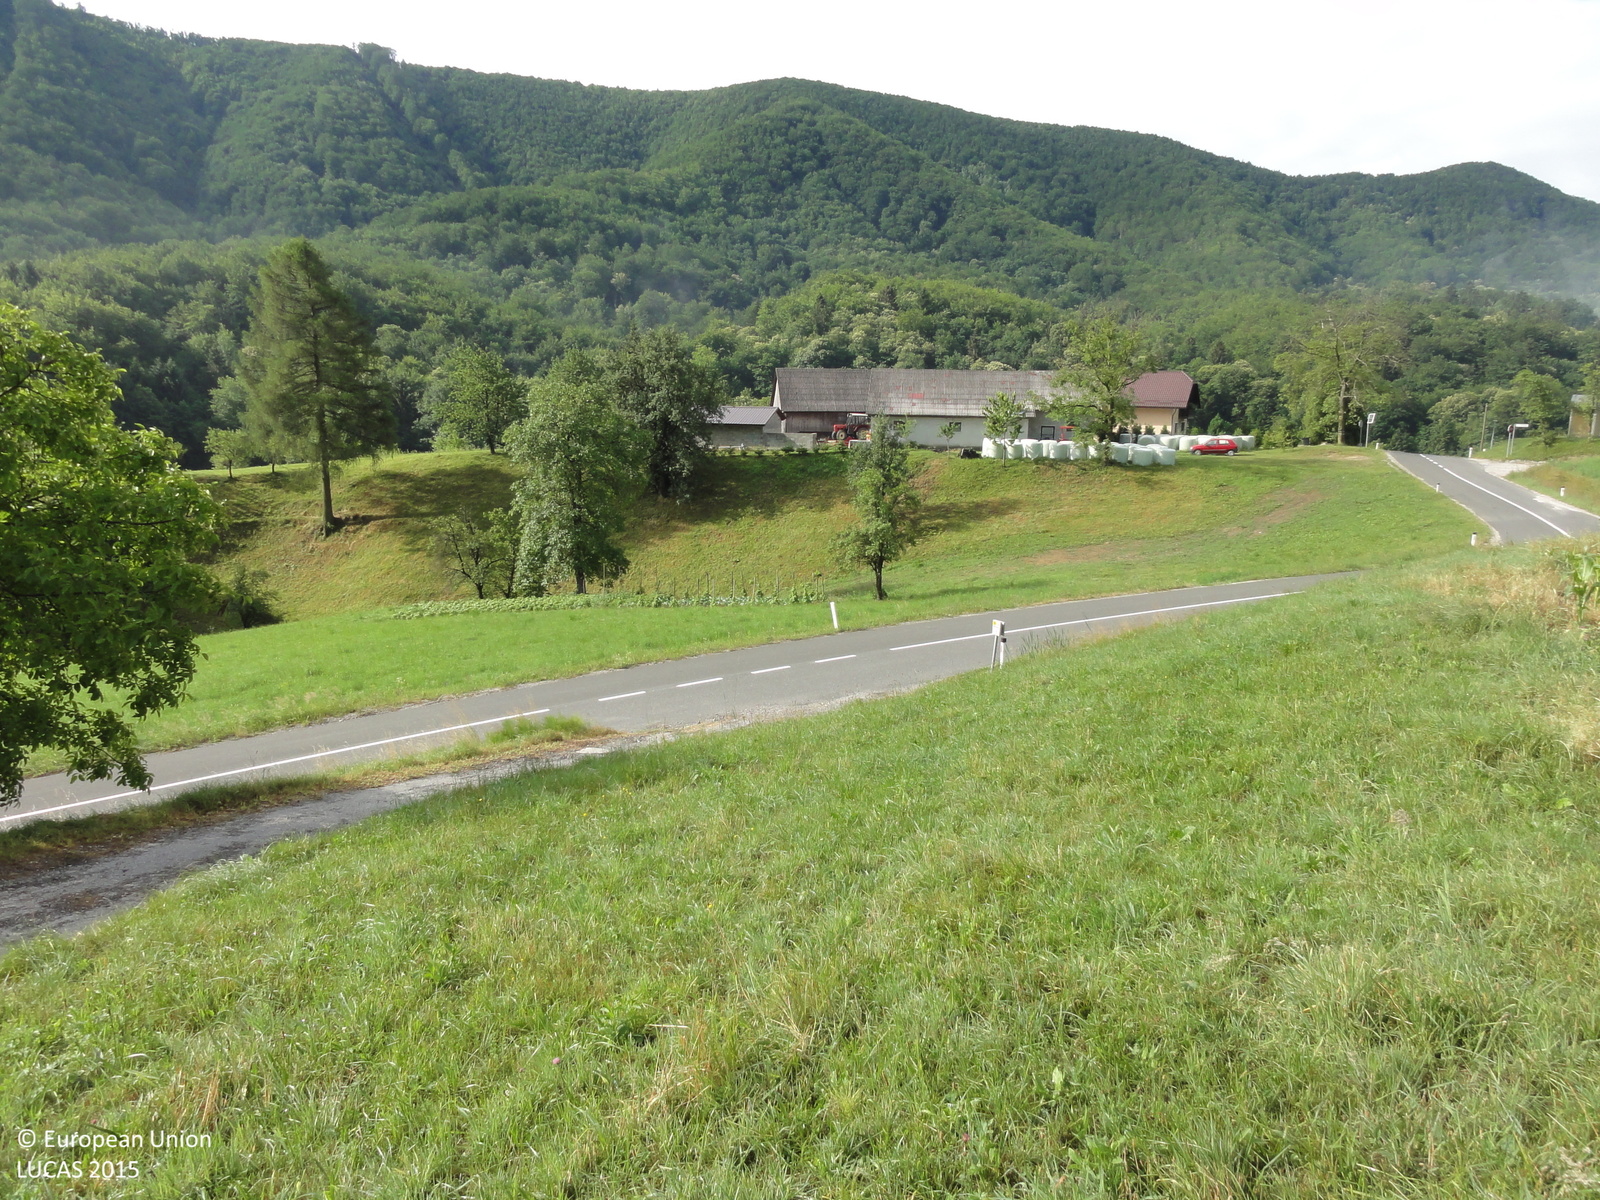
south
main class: Grassland
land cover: Grassland without tree/shrub cover
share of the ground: > 75 %
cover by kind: herbaceous plants 100 %
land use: Agriculture (excluding fallow land and kitchen gardens)
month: June
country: SI
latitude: 46.2675
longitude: 15.7726
